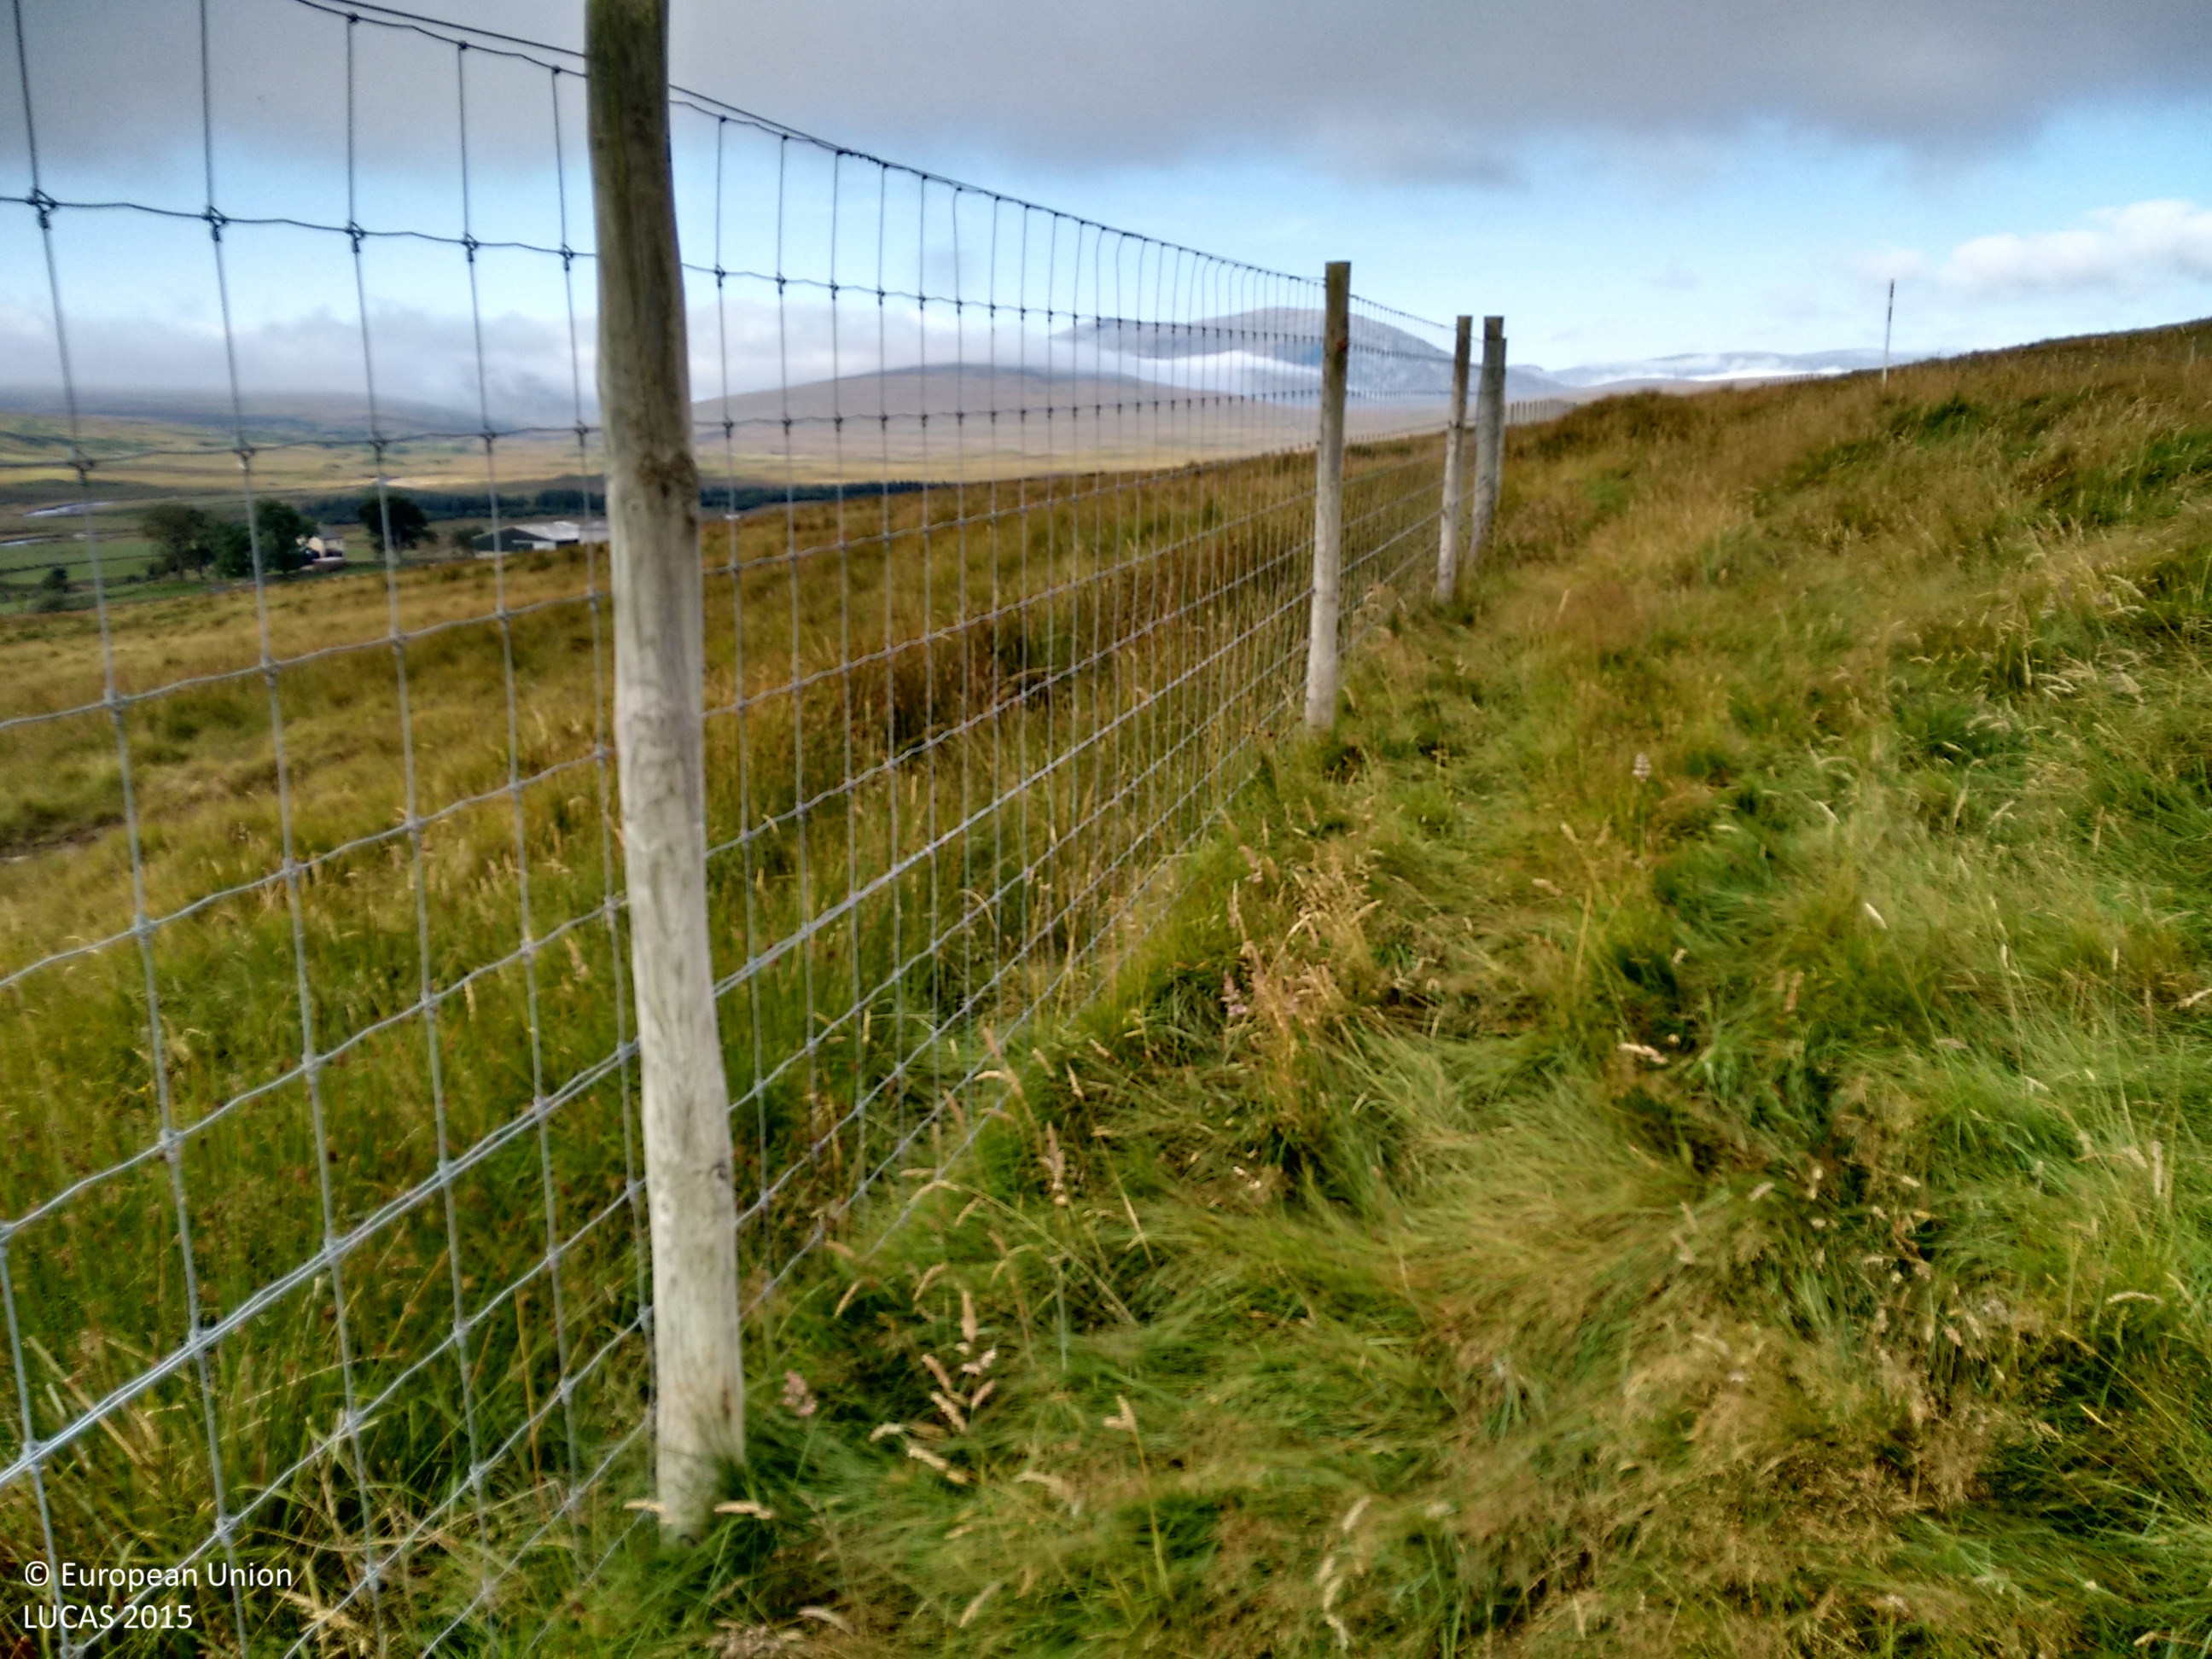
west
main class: Grassland
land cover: Grassland without tree/shrub cover
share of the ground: > 75 %
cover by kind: herbaceous plants 100 %
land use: Agriculture (excluding fallow land and kitchen gardens)
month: September
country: GB
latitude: 58.2886
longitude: -4.4993
